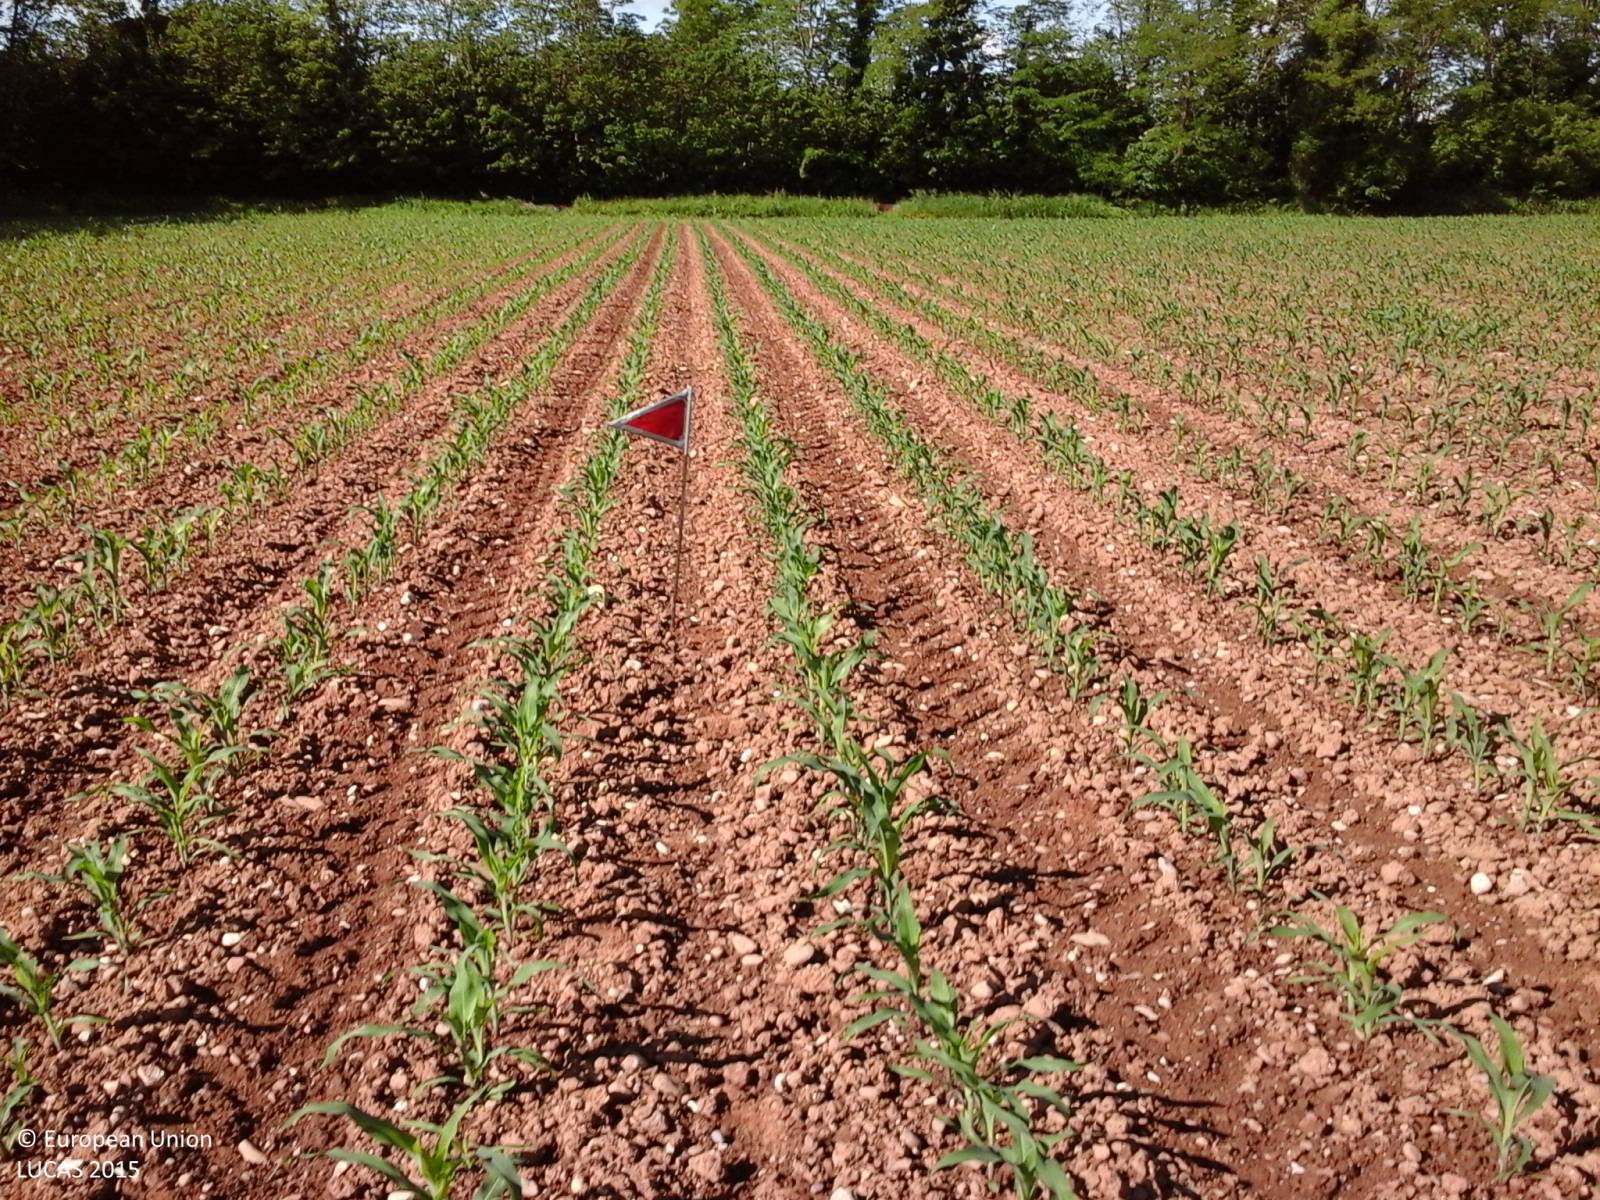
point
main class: Cropland
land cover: Maize
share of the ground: 10 - 25 %
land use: Agriculture (excluding fallow land and kitchen gardens)
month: May
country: IT
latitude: 45.9786
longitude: 13.2103
